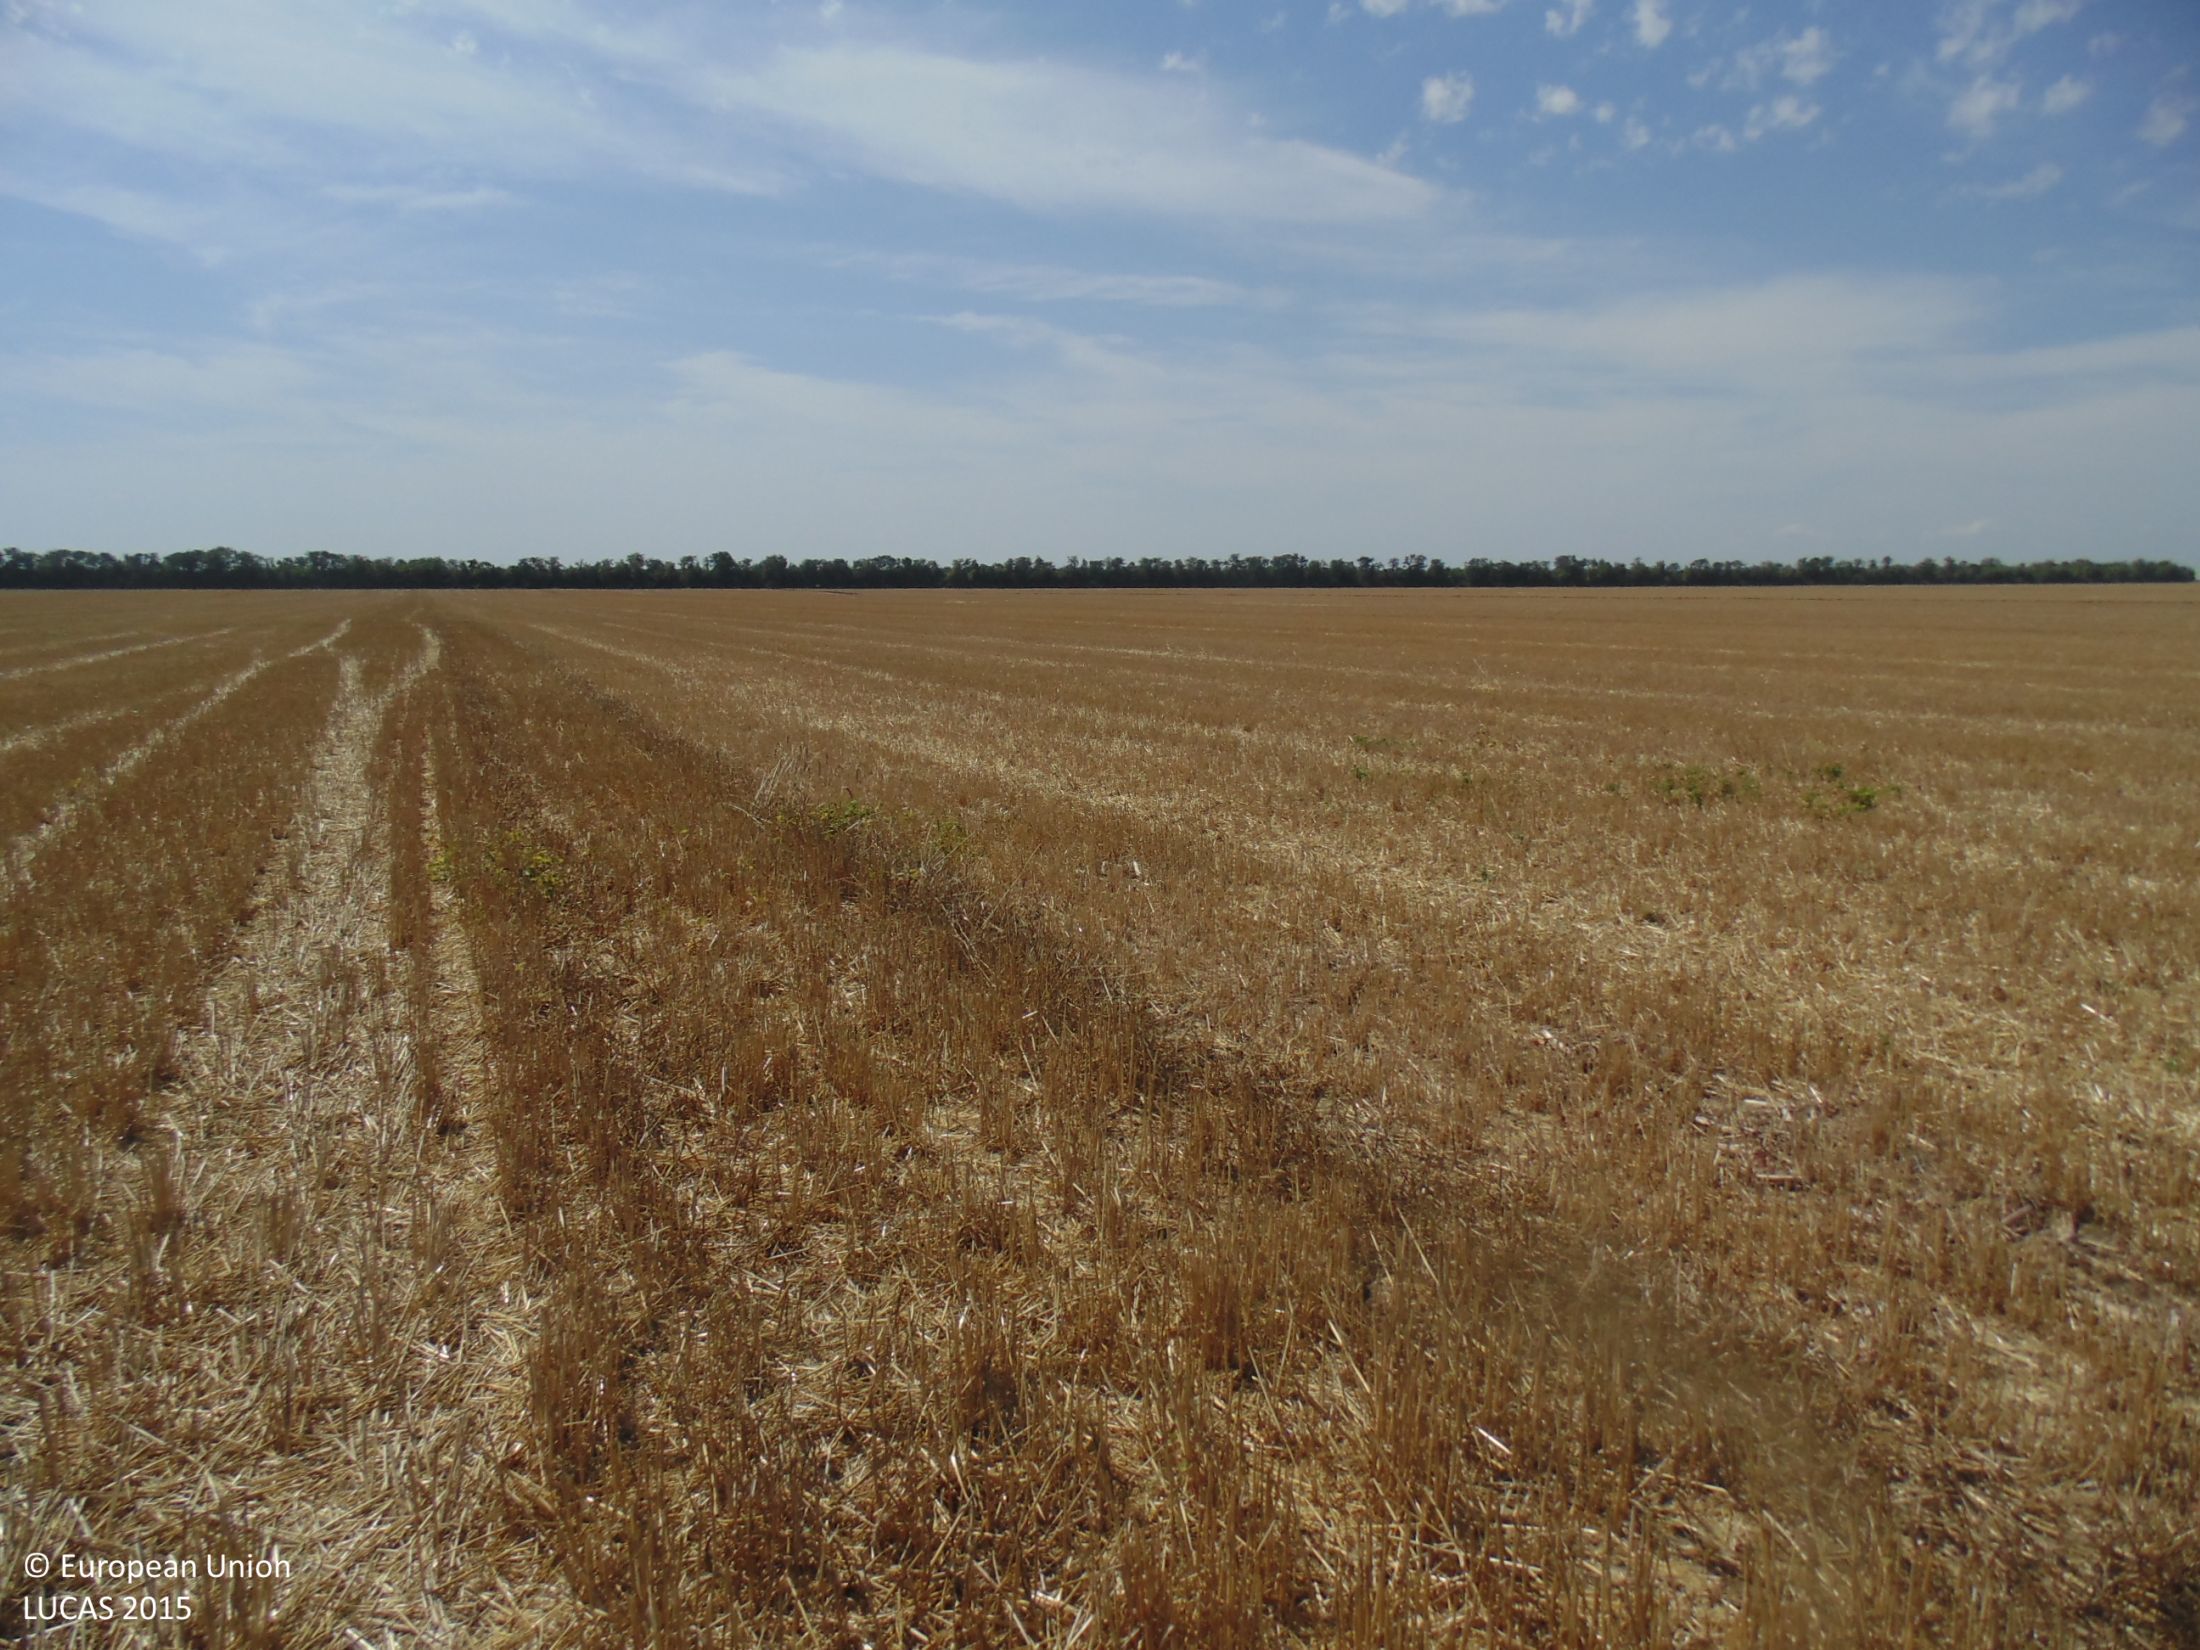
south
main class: Cropland
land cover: Common wheat
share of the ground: > 75 %
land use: Agriculture (excluding fallow land and kitchen gardens)
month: August
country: BG
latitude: 43.7352
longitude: 28.5280
